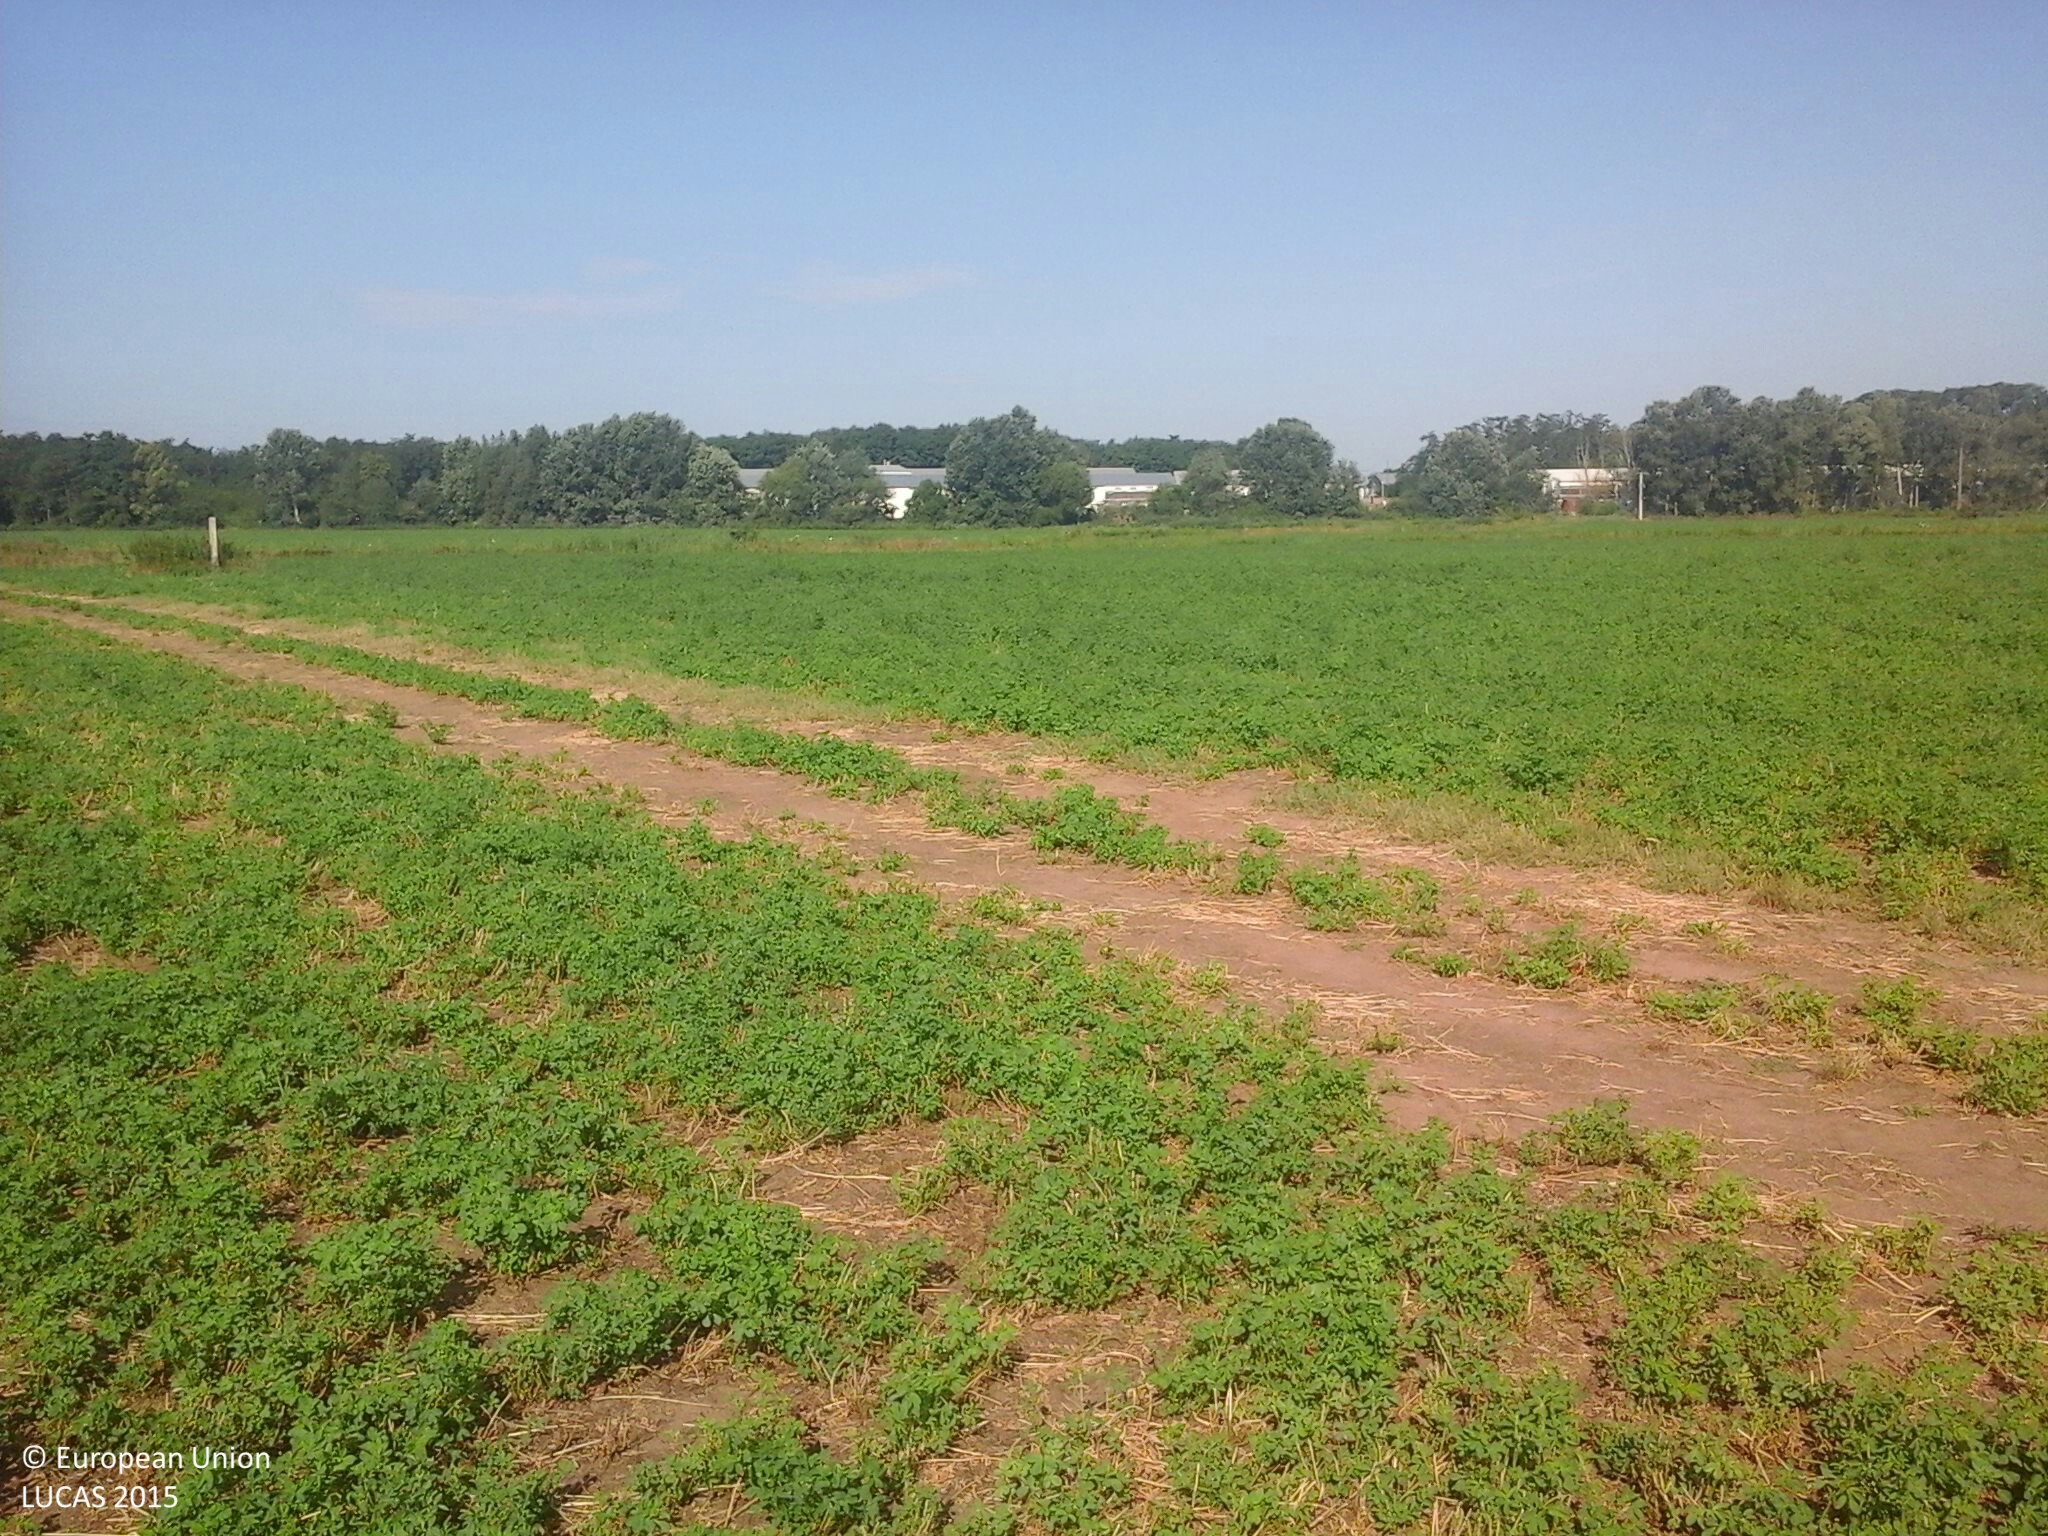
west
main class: Cropland
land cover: Lucerne
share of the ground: > 75 %
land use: Agriculture (excluding fallow land and kitchen gardens)
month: July
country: HU
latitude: 47.8018
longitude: 22.1635
